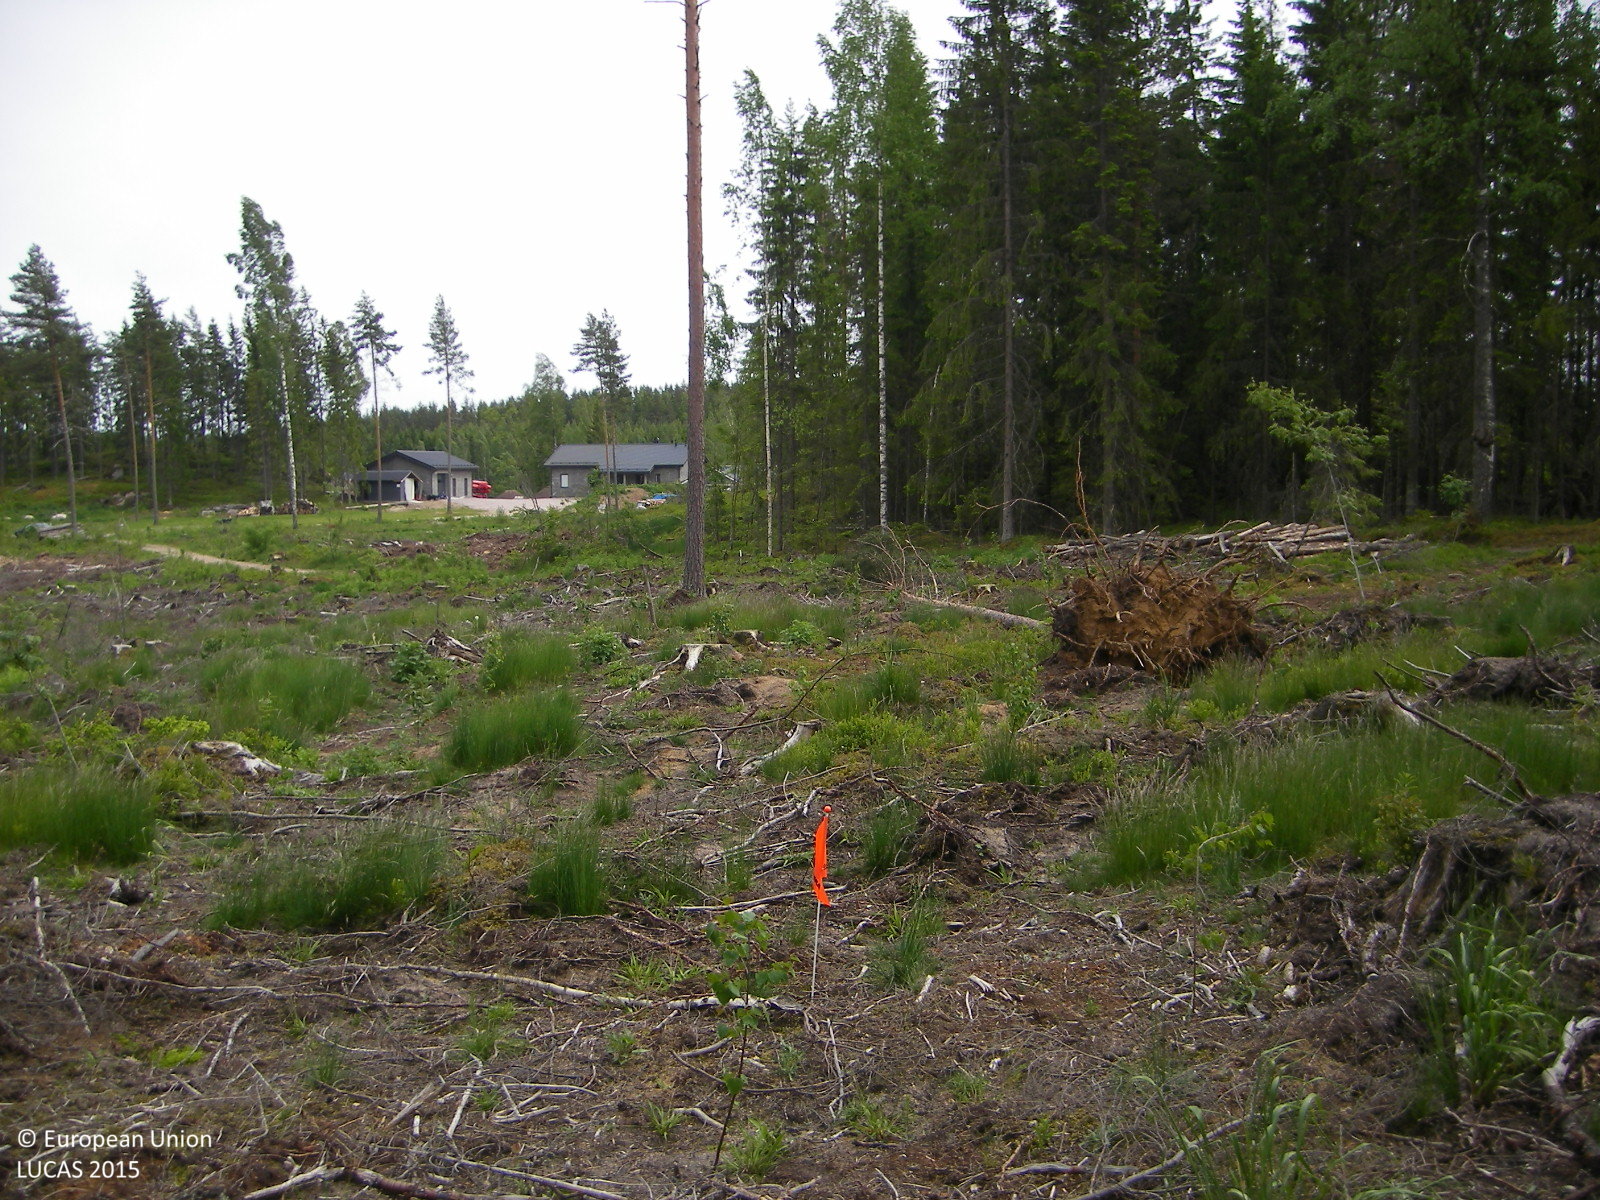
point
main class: Grassland
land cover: Grassland with sparse tree/shrub cover
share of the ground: 25 - 50 %
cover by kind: unconsolidated bare surface 50 %, herbaceous plants 40 %, broadleaved forest trees 5 %, shrubs 5 %
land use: Forestry
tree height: < 5 m
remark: Clear cut
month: June
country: FI
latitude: 60.3180
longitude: 24.3895
